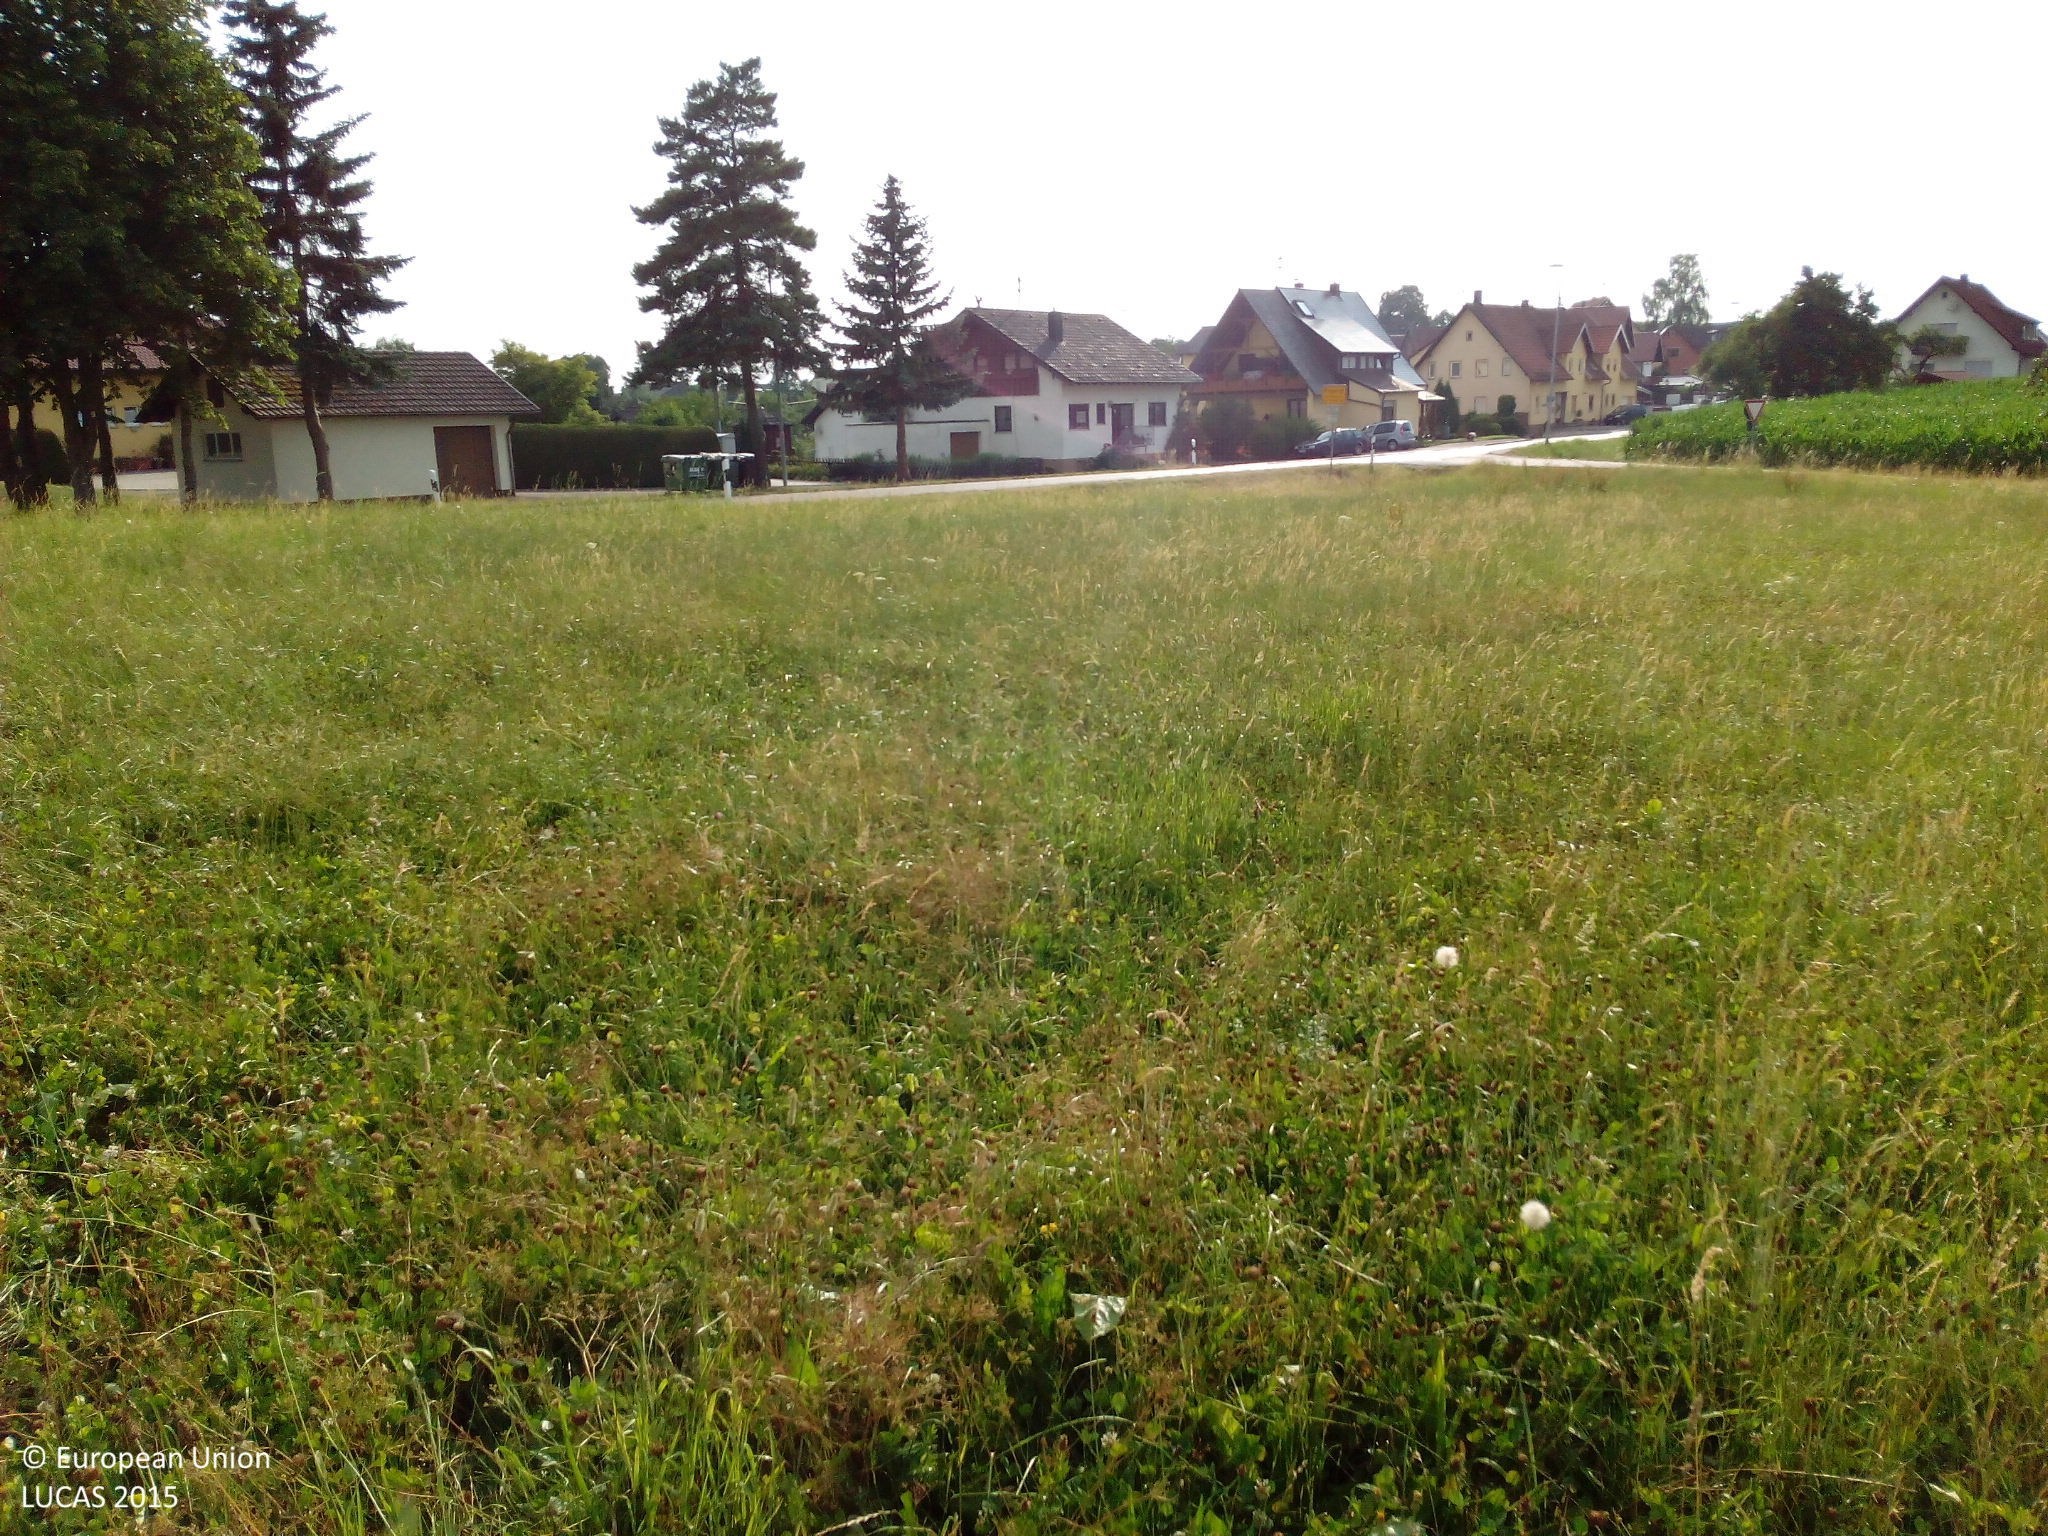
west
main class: Cropland
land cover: Common wheat
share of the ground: > 75 %
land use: Agriculture (excluding fallow land and kitchen gardens)
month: July
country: DE
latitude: 49.0332
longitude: 9.9590
